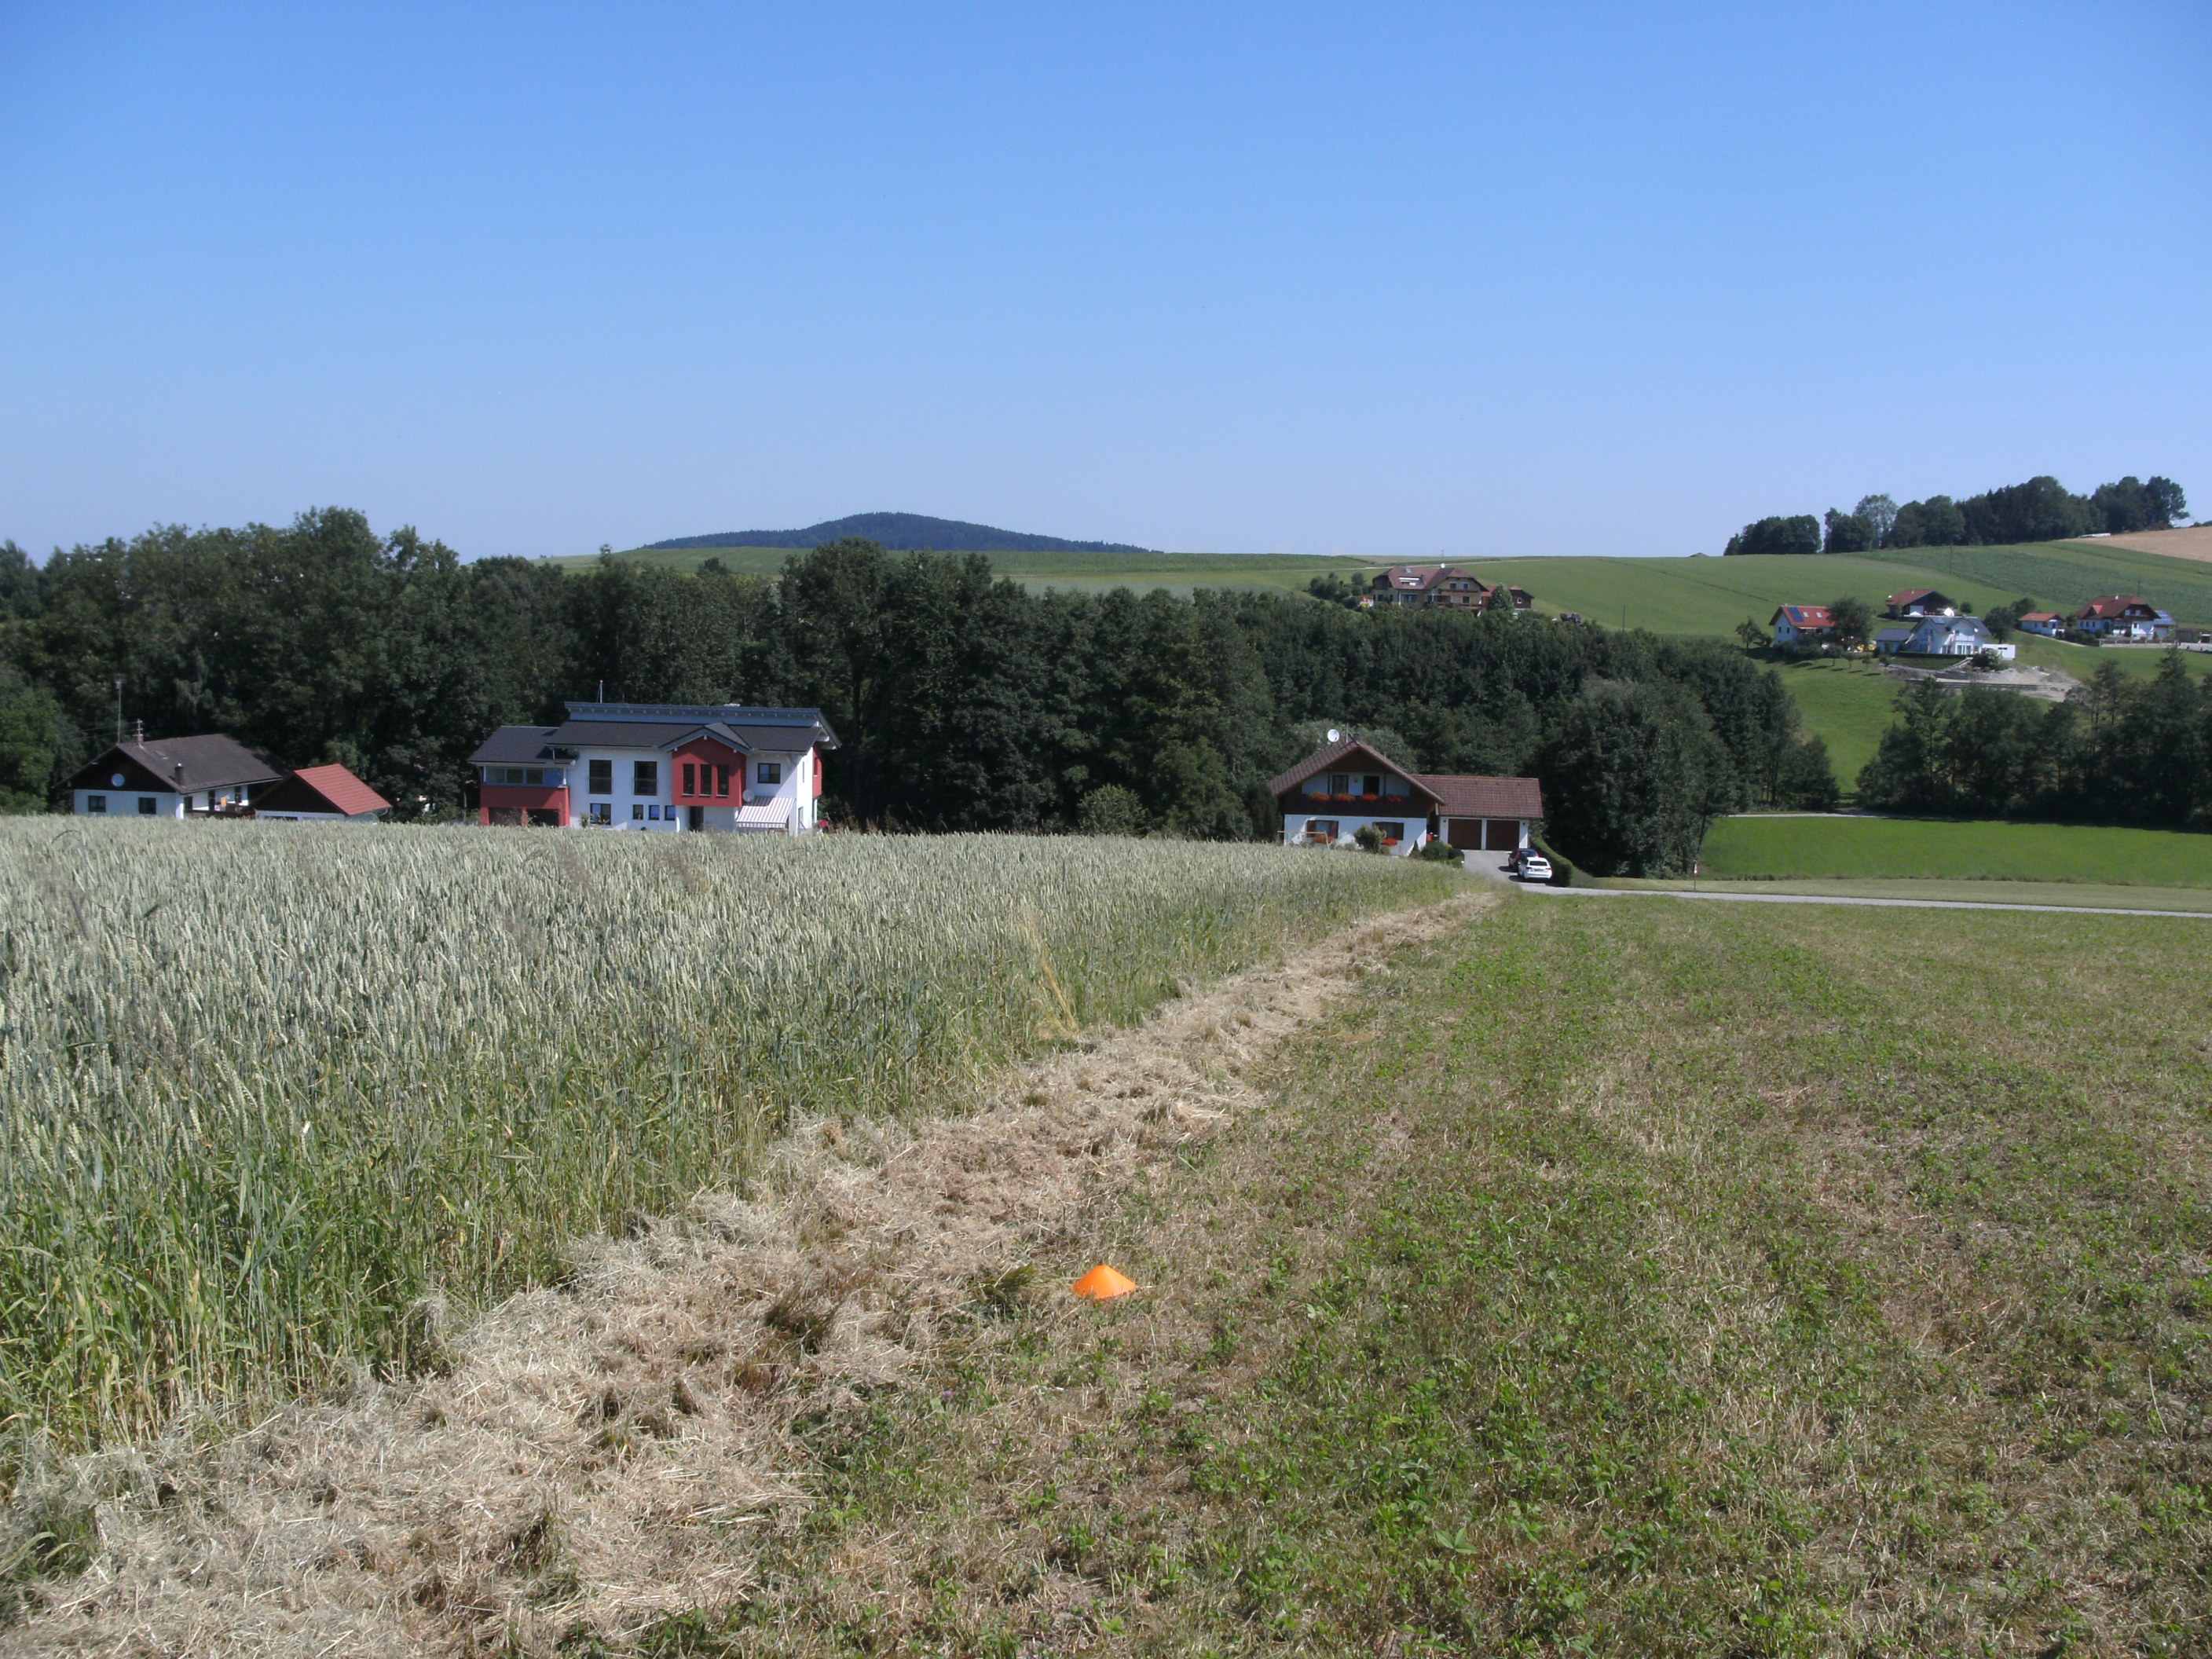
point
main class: Cropland
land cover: Common wheat
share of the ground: > 75 %
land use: Agriculture (excluding fallow land and kitchen gardens)
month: July
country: AT
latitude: 48.1318
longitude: 13.5062
